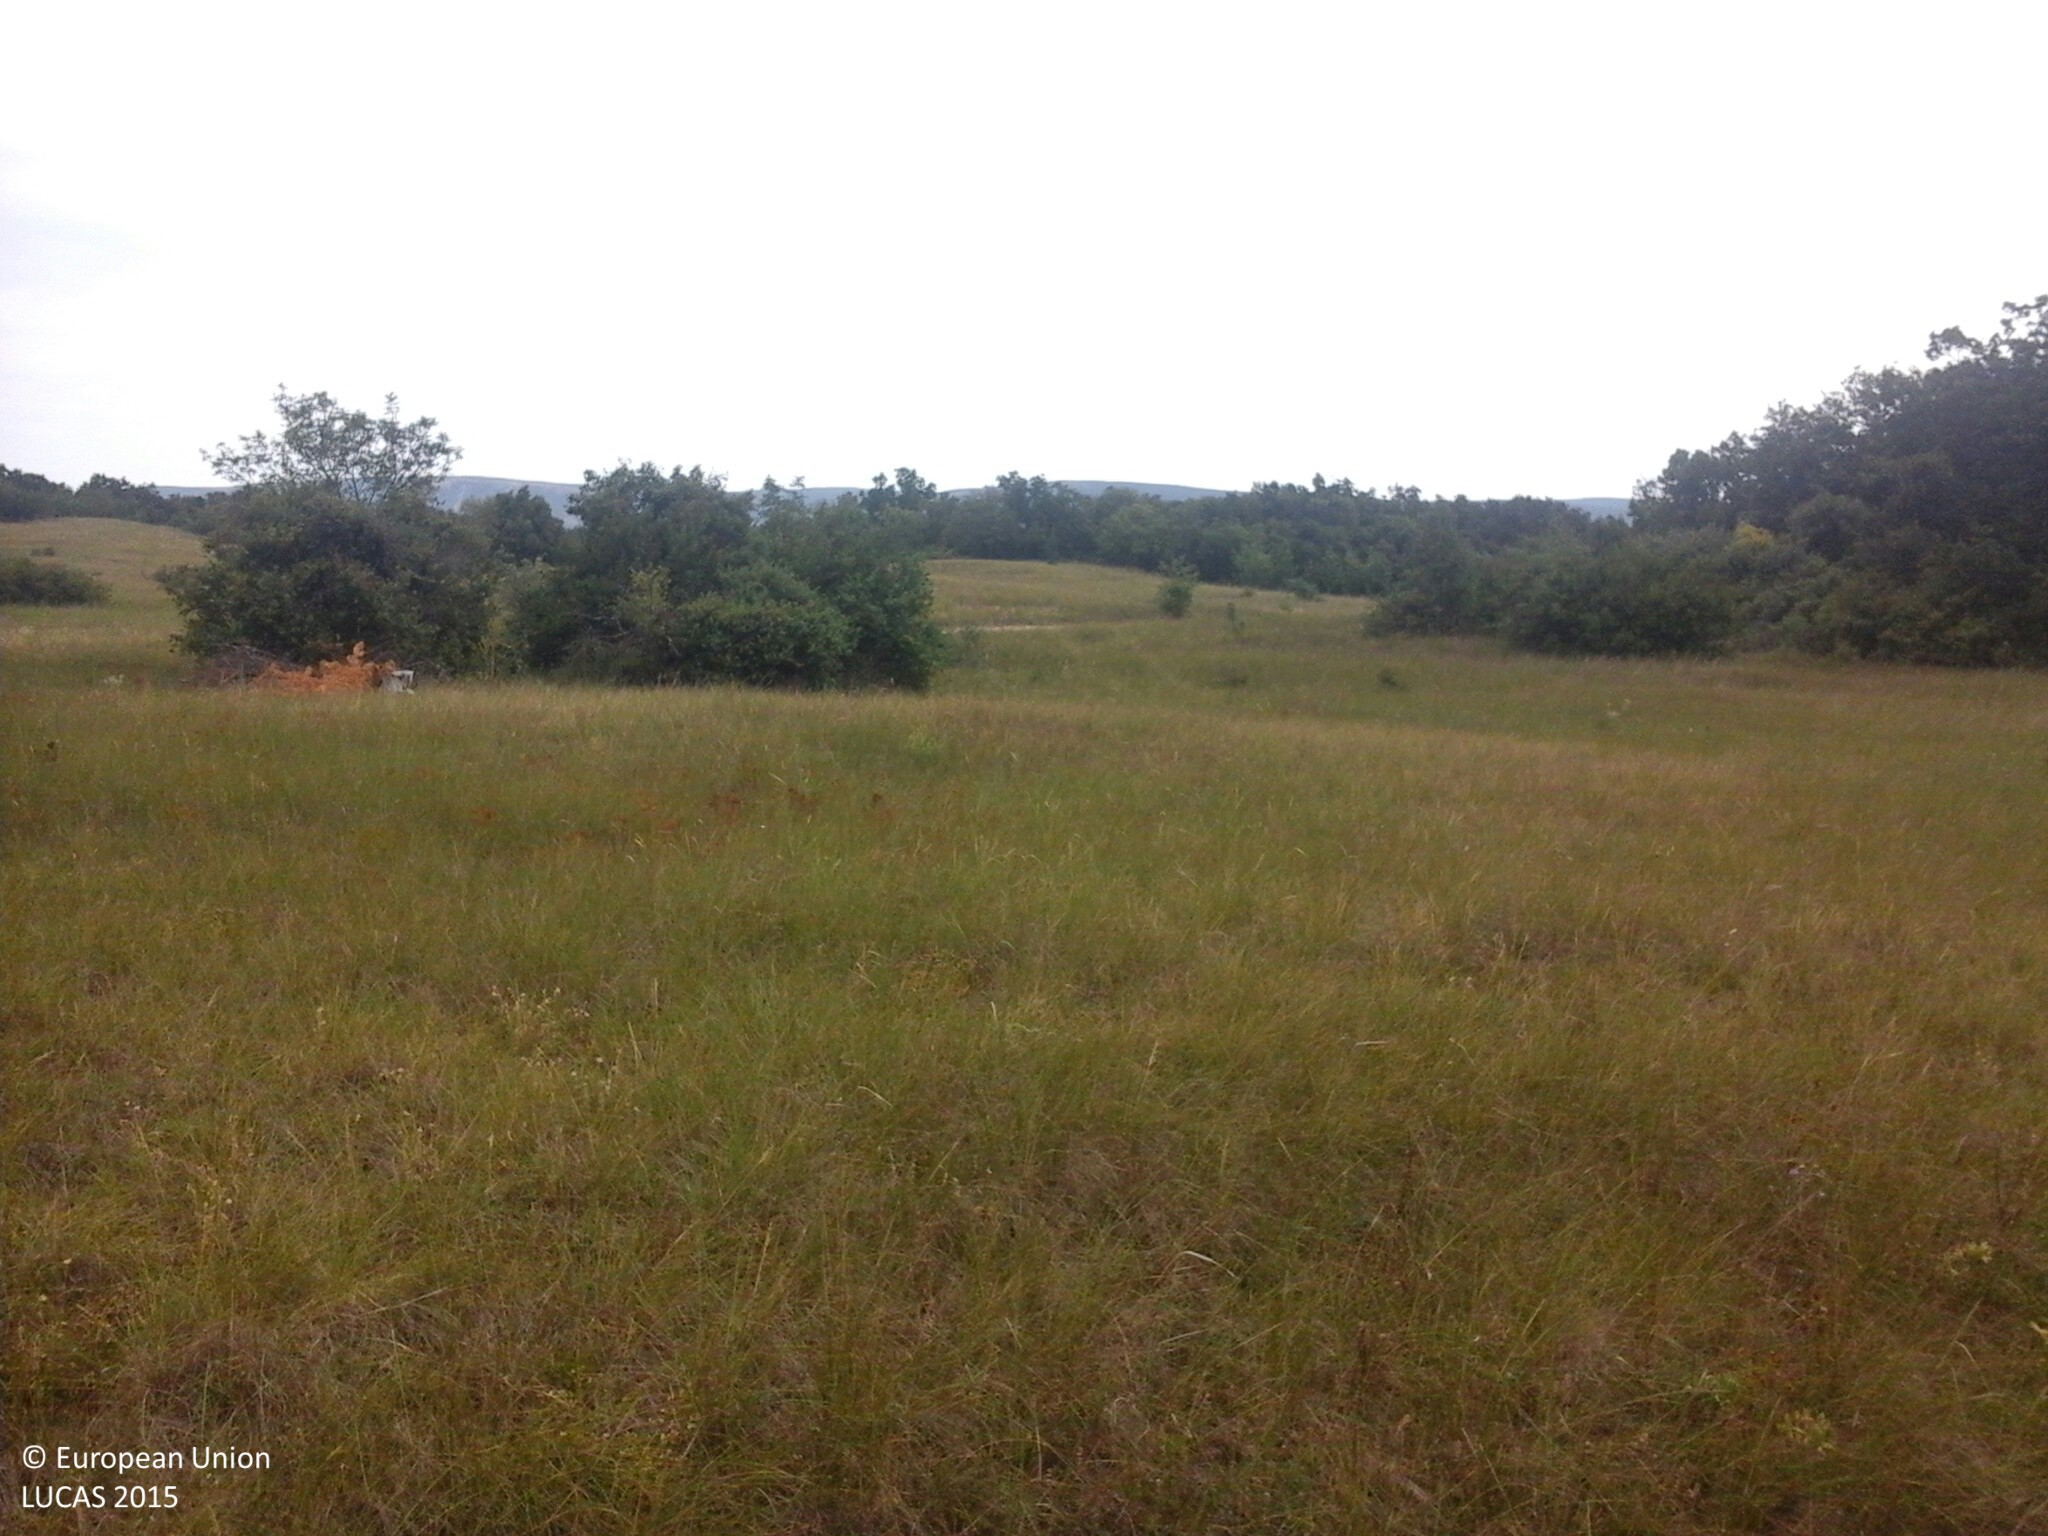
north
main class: Grassland
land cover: Grassland without tree/shrub cover
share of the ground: > 75 %
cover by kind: herbaceous plants 100 %
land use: Agriculture (excluding fallow land and kitchen gardens)
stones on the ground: 10 - 25 %
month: July
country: HU
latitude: 47.1498
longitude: 18.0679
